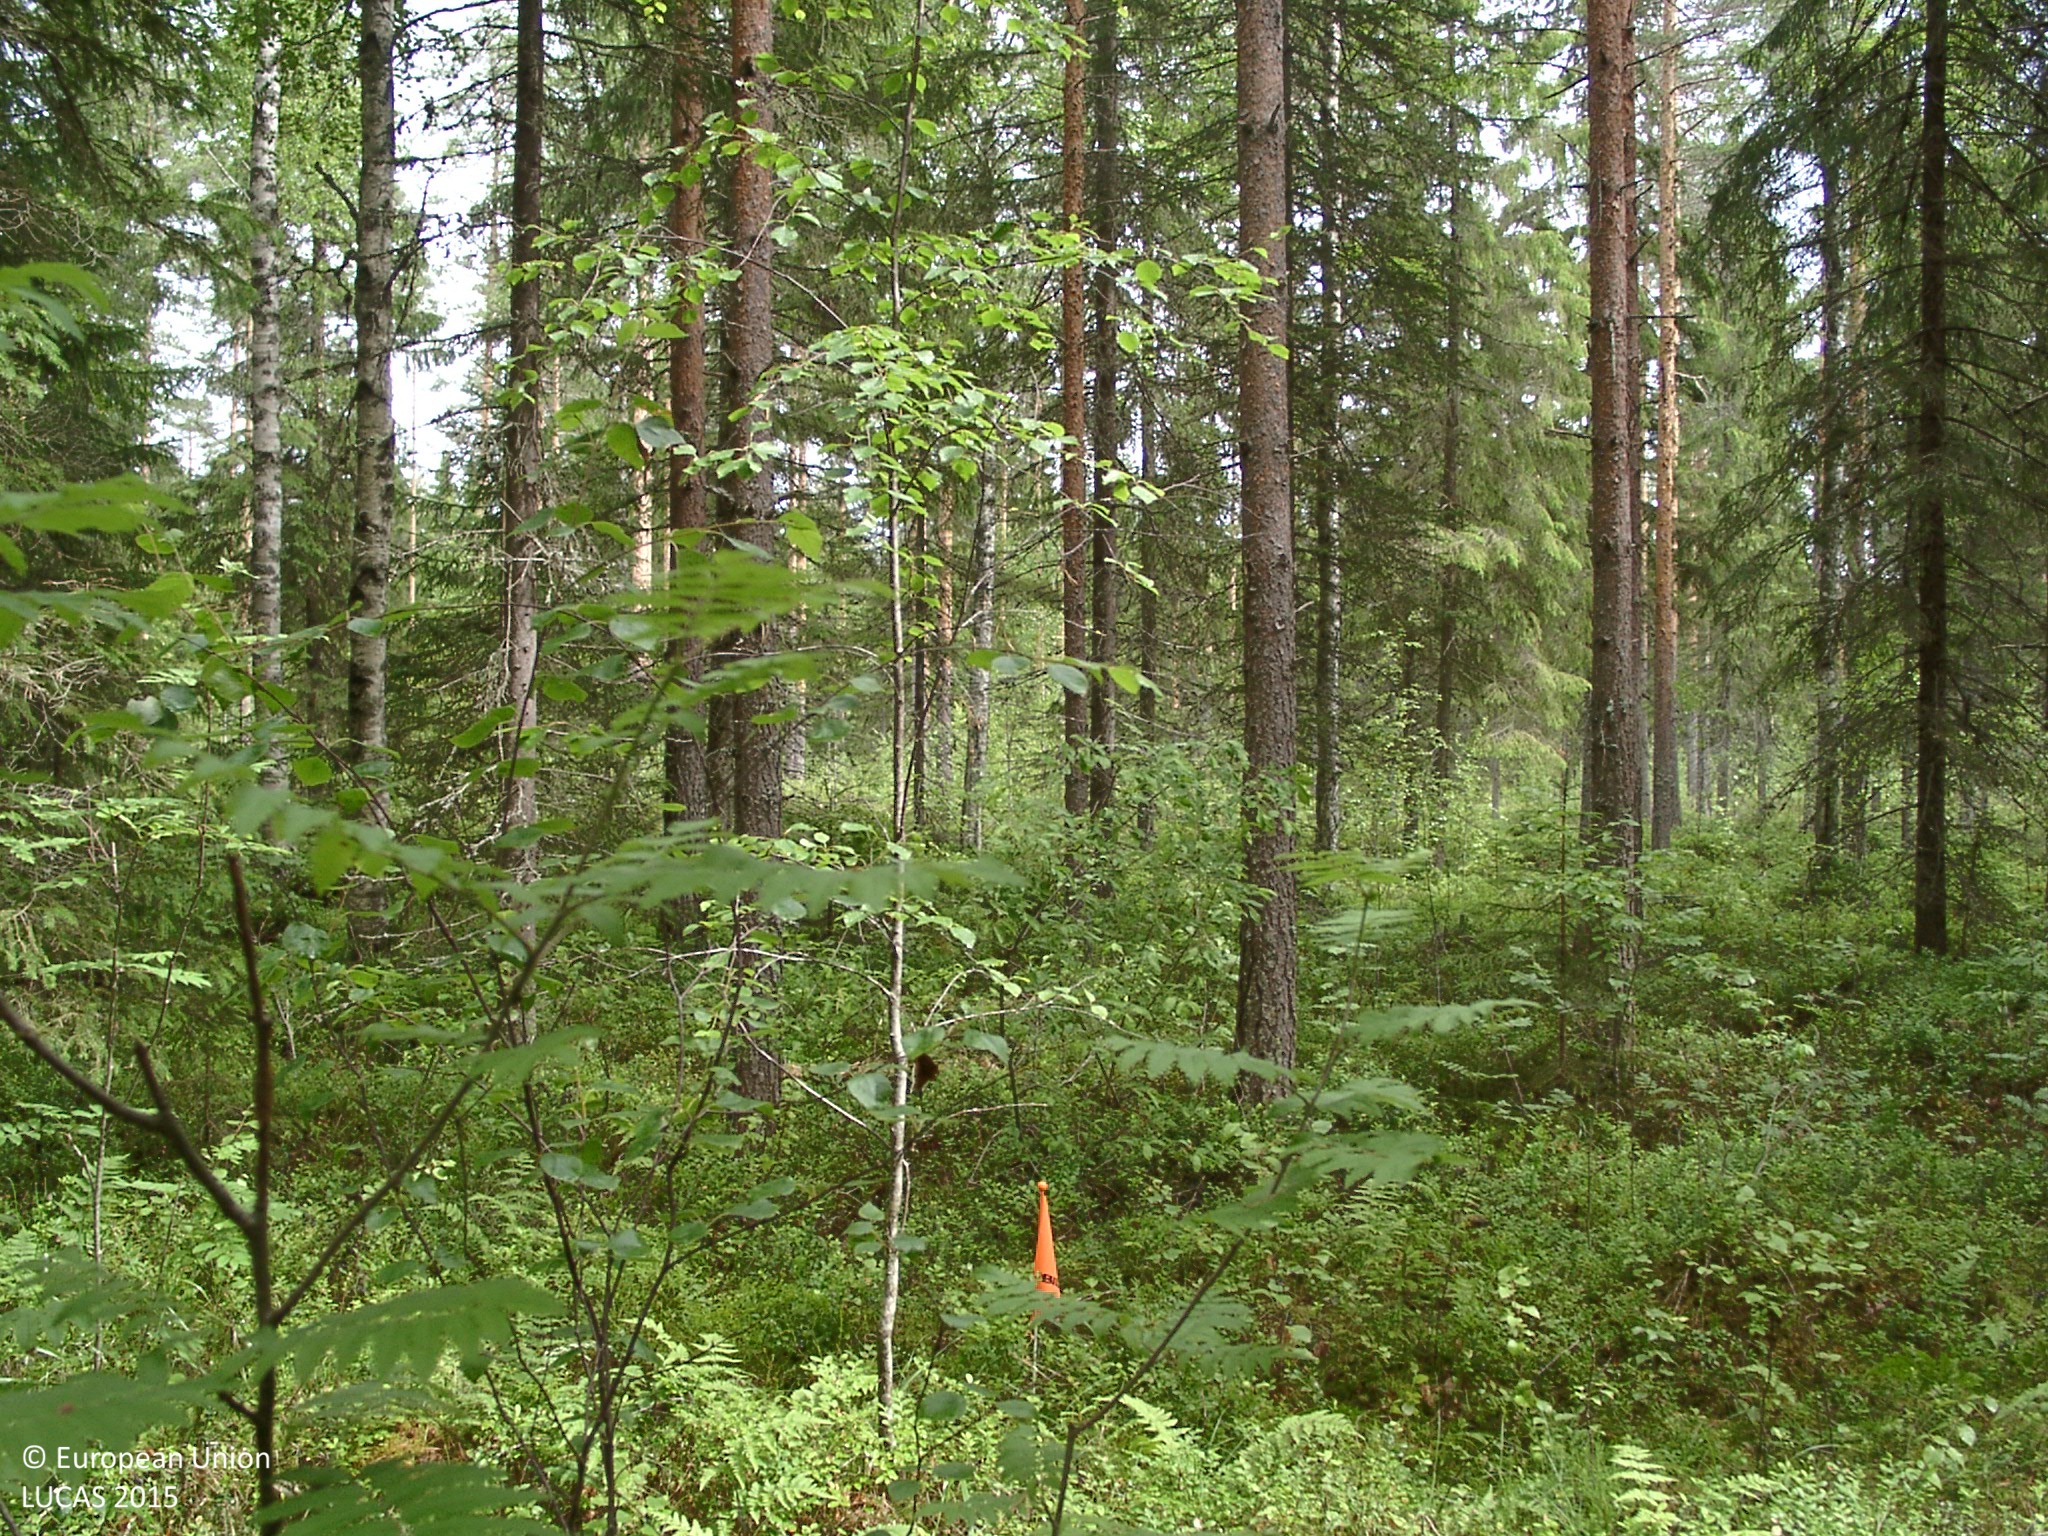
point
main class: Woodland
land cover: Other mixed woodland
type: boreal forest
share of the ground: 50 - 75 %
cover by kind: coniferous forest trees 45 %, broadleaved forest trees 25 %, shrubs 20 %, lichens and mosses 10 %
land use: Forestry
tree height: > 5 m
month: July
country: FI
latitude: 61.6456
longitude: 24.8847
